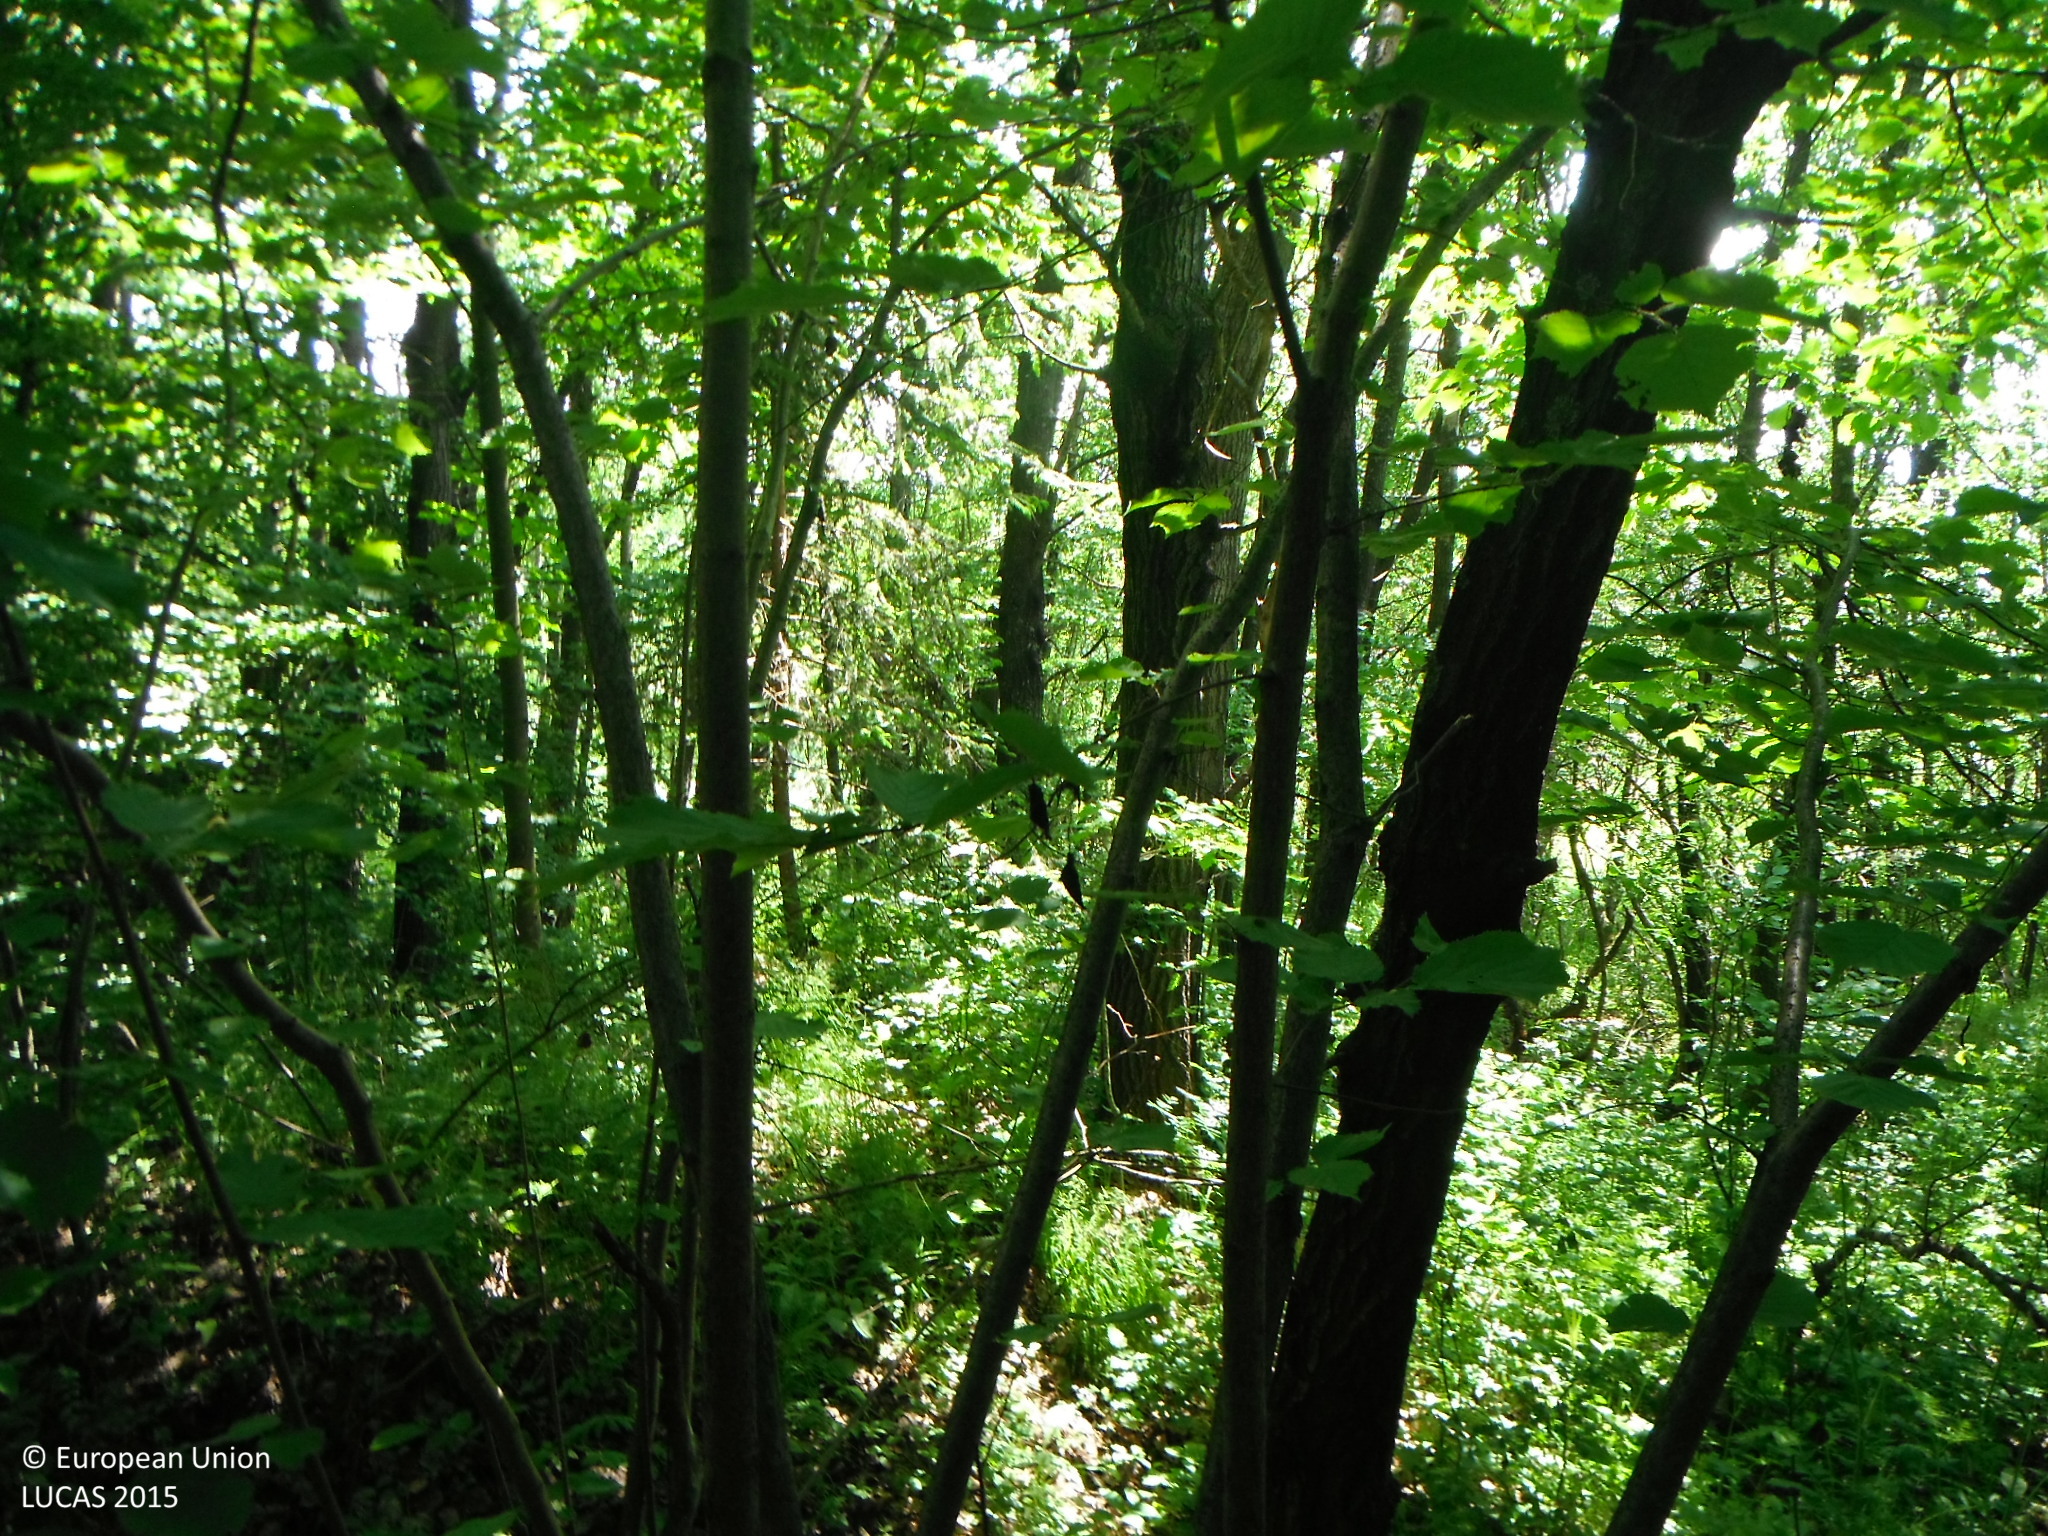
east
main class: Woodland
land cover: Broadleaved woodland
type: mesophytic deciduous forest
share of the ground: > 75 %
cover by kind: broadleaved forest trees 95 %, shrubs 5 %
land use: Semi-natural and natural areas not in use
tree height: > 5 m
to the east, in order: Broadleaved woodland; Tracks; Shrubland without tree cover; Grassland without tree/shrub cover; Shrubland without tree cover; Broadleaved woodland; Rivers and streams; Broadleaved woodland; Spruce dominated coniferous woodland
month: June
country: SK
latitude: 48.8159
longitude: 19.6278
